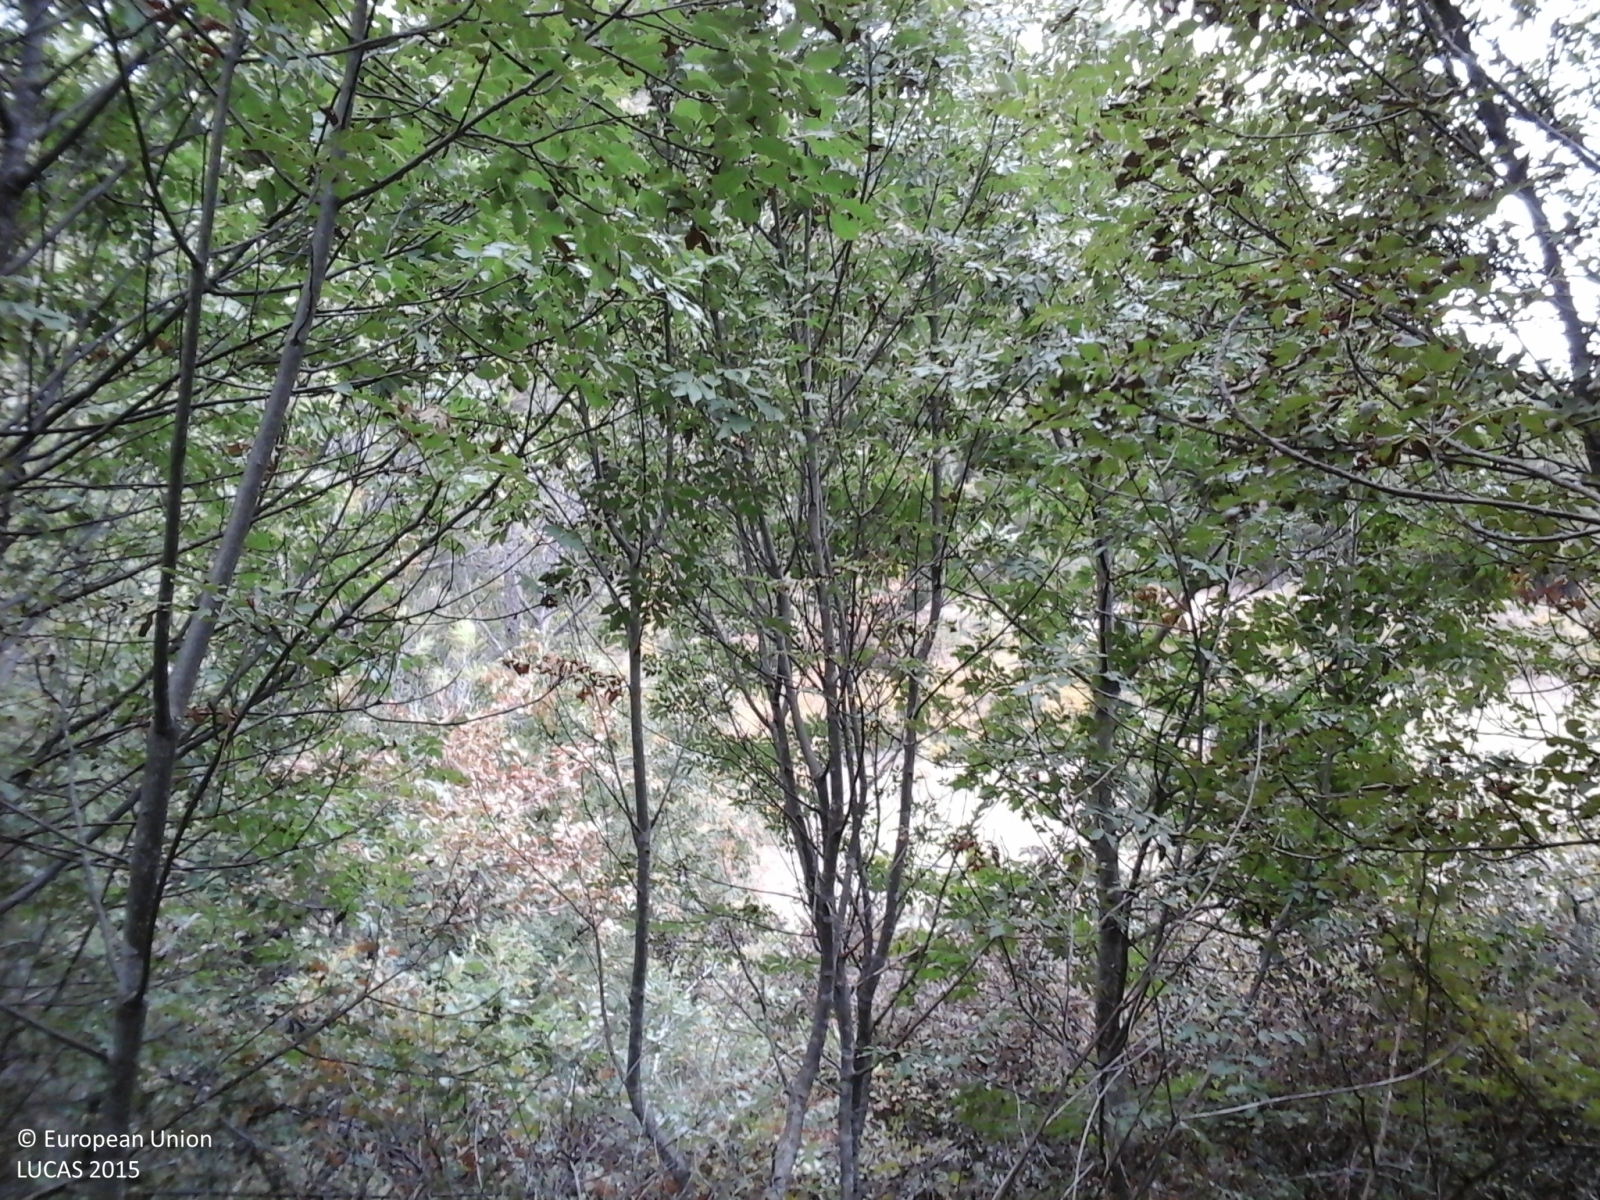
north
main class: Woodland
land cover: Broadleaved woodland
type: thermophilous deciduous forest
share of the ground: > 75 %
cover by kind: broadleaved forest trees 100 %
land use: Forestry
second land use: Other primary production
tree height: < 5 m
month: September
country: IT
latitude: 43.3736
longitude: 12.8188
